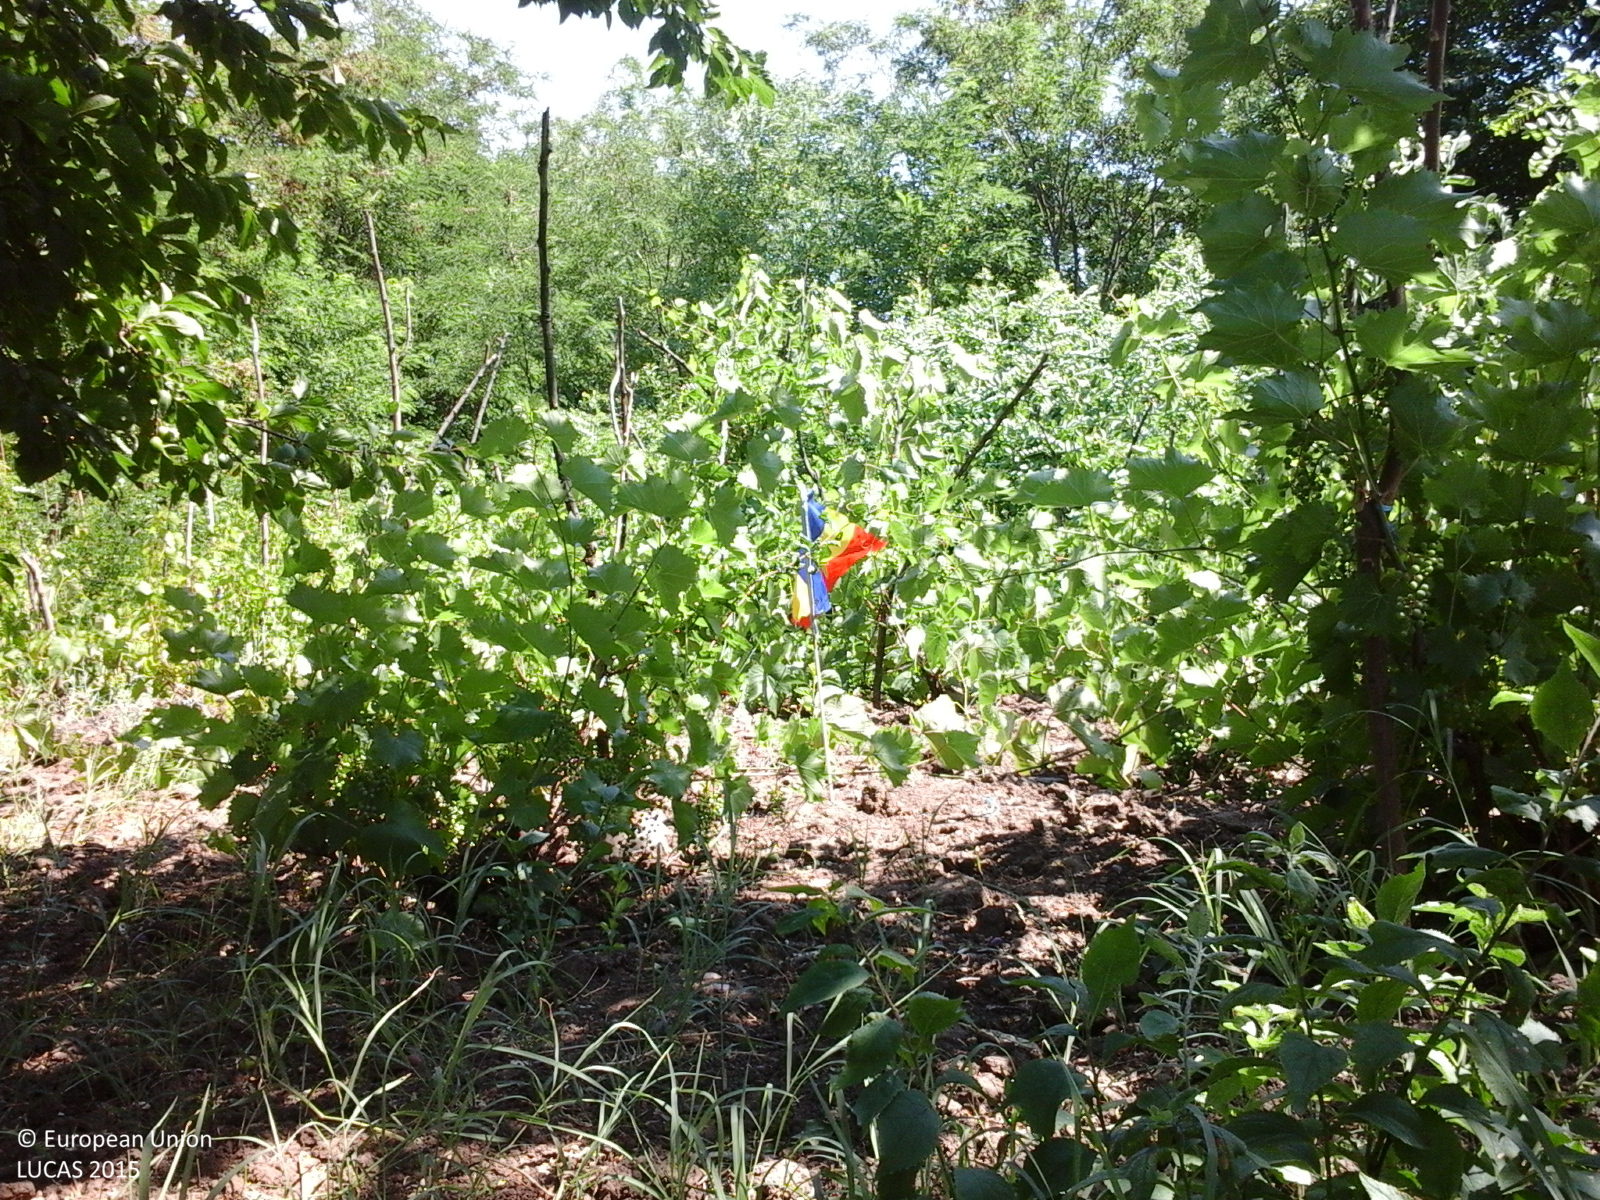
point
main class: Cropland
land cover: Vineyards
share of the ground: > 75 %
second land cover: Other bare soil
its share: > 75 %
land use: Kitchen garden
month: June
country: RO
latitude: 46.8968
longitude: 28.0753
